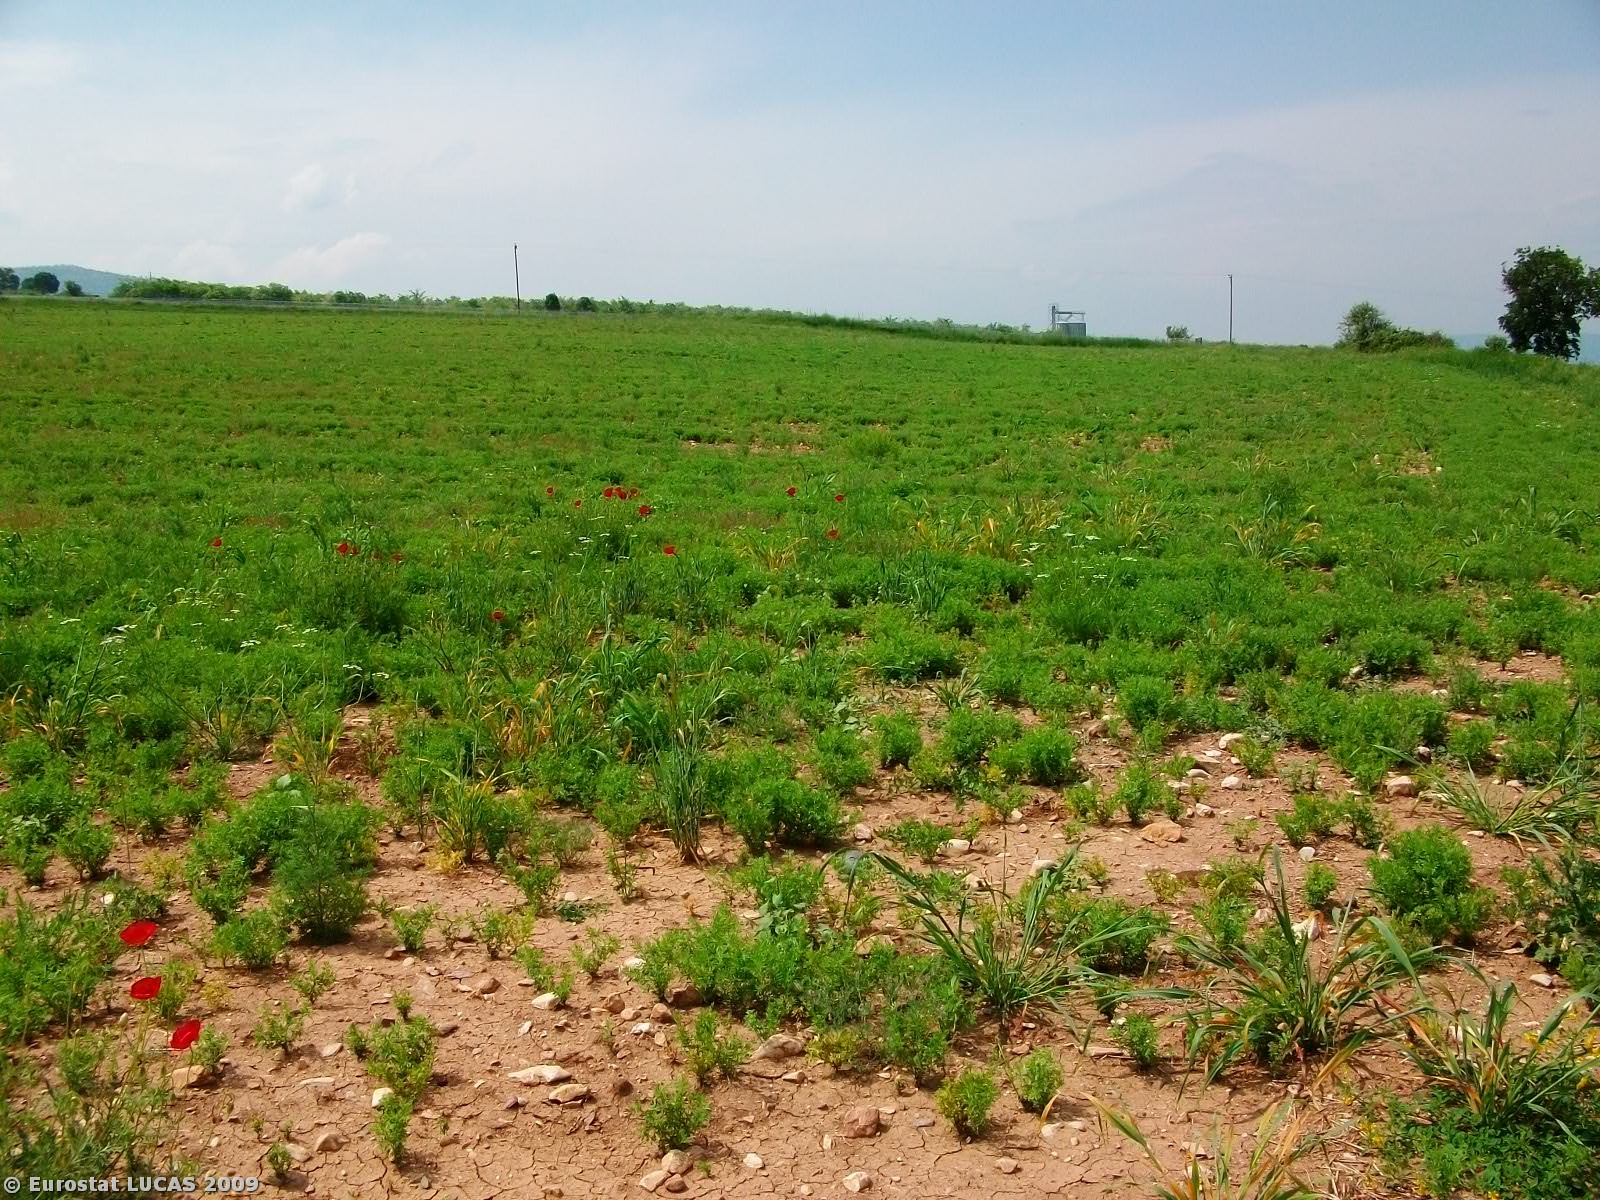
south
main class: Cropland
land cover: Dry pulses
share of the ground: 10 - 25 %
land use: Agriculture (excluding fallow land and kitchen gardens)
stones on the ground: 10 - 25 %
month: May
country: GR
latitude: 39.9451
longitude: 21.7264
